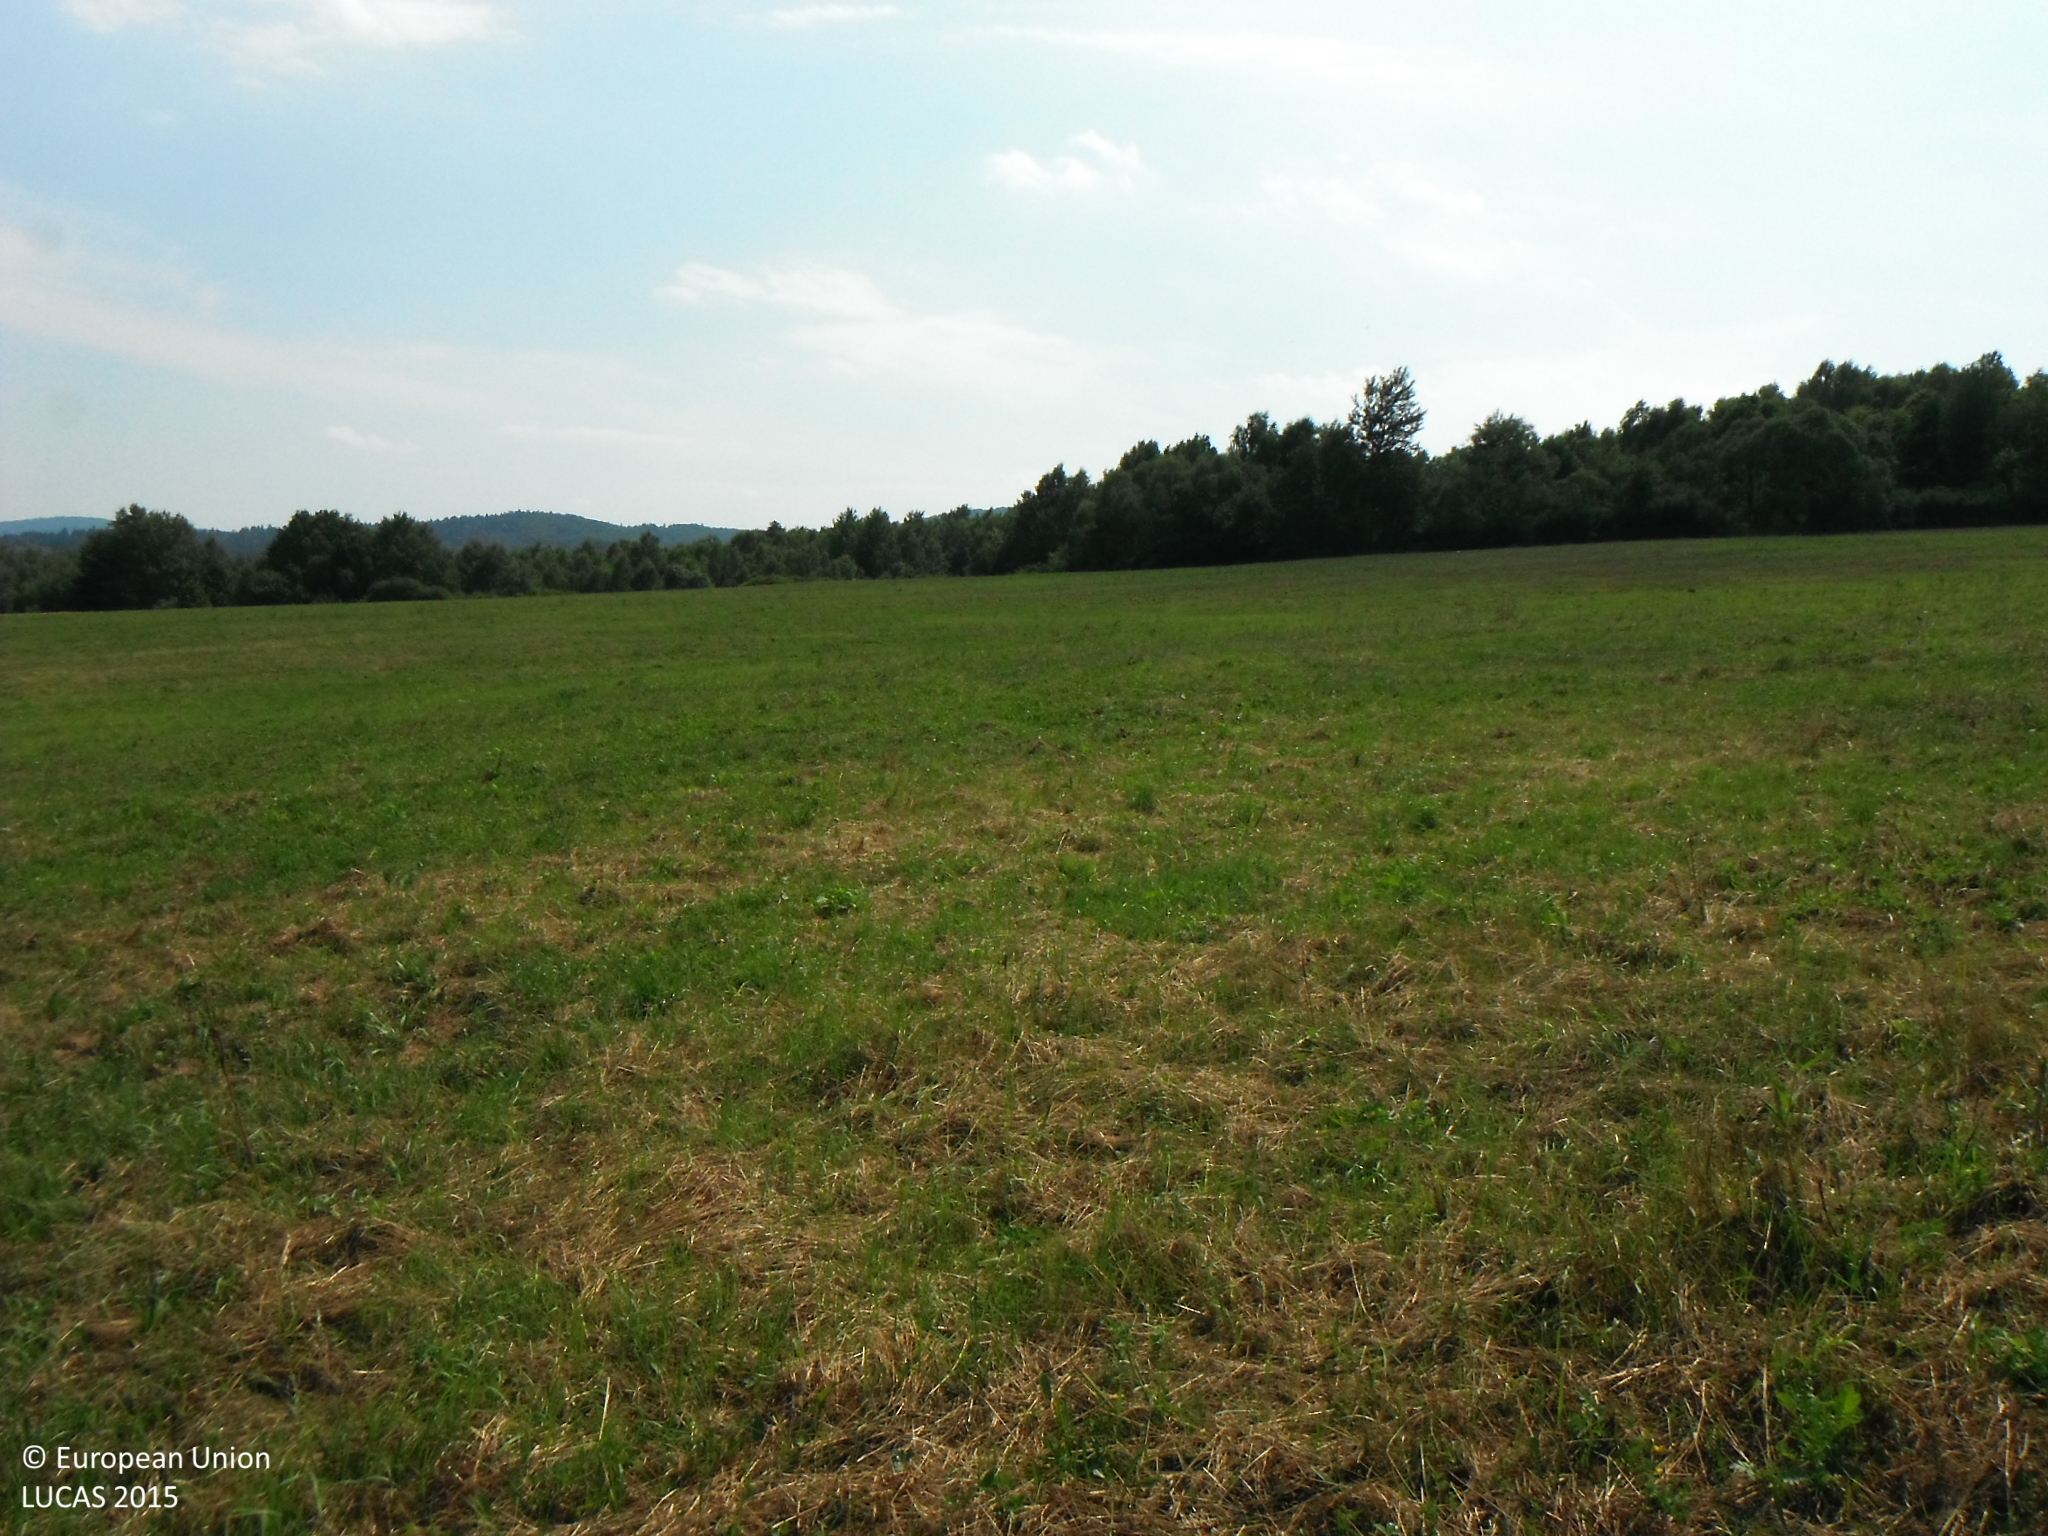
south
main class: Grassland
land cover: Grassland without tree/shrub cover
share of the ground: > 75 %
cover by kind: herbaceous plants 100 %
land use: Agriculture (excluding fallow land and kitchen gardens)
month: July
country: SK
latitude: 49.3676
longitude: 21.4647
